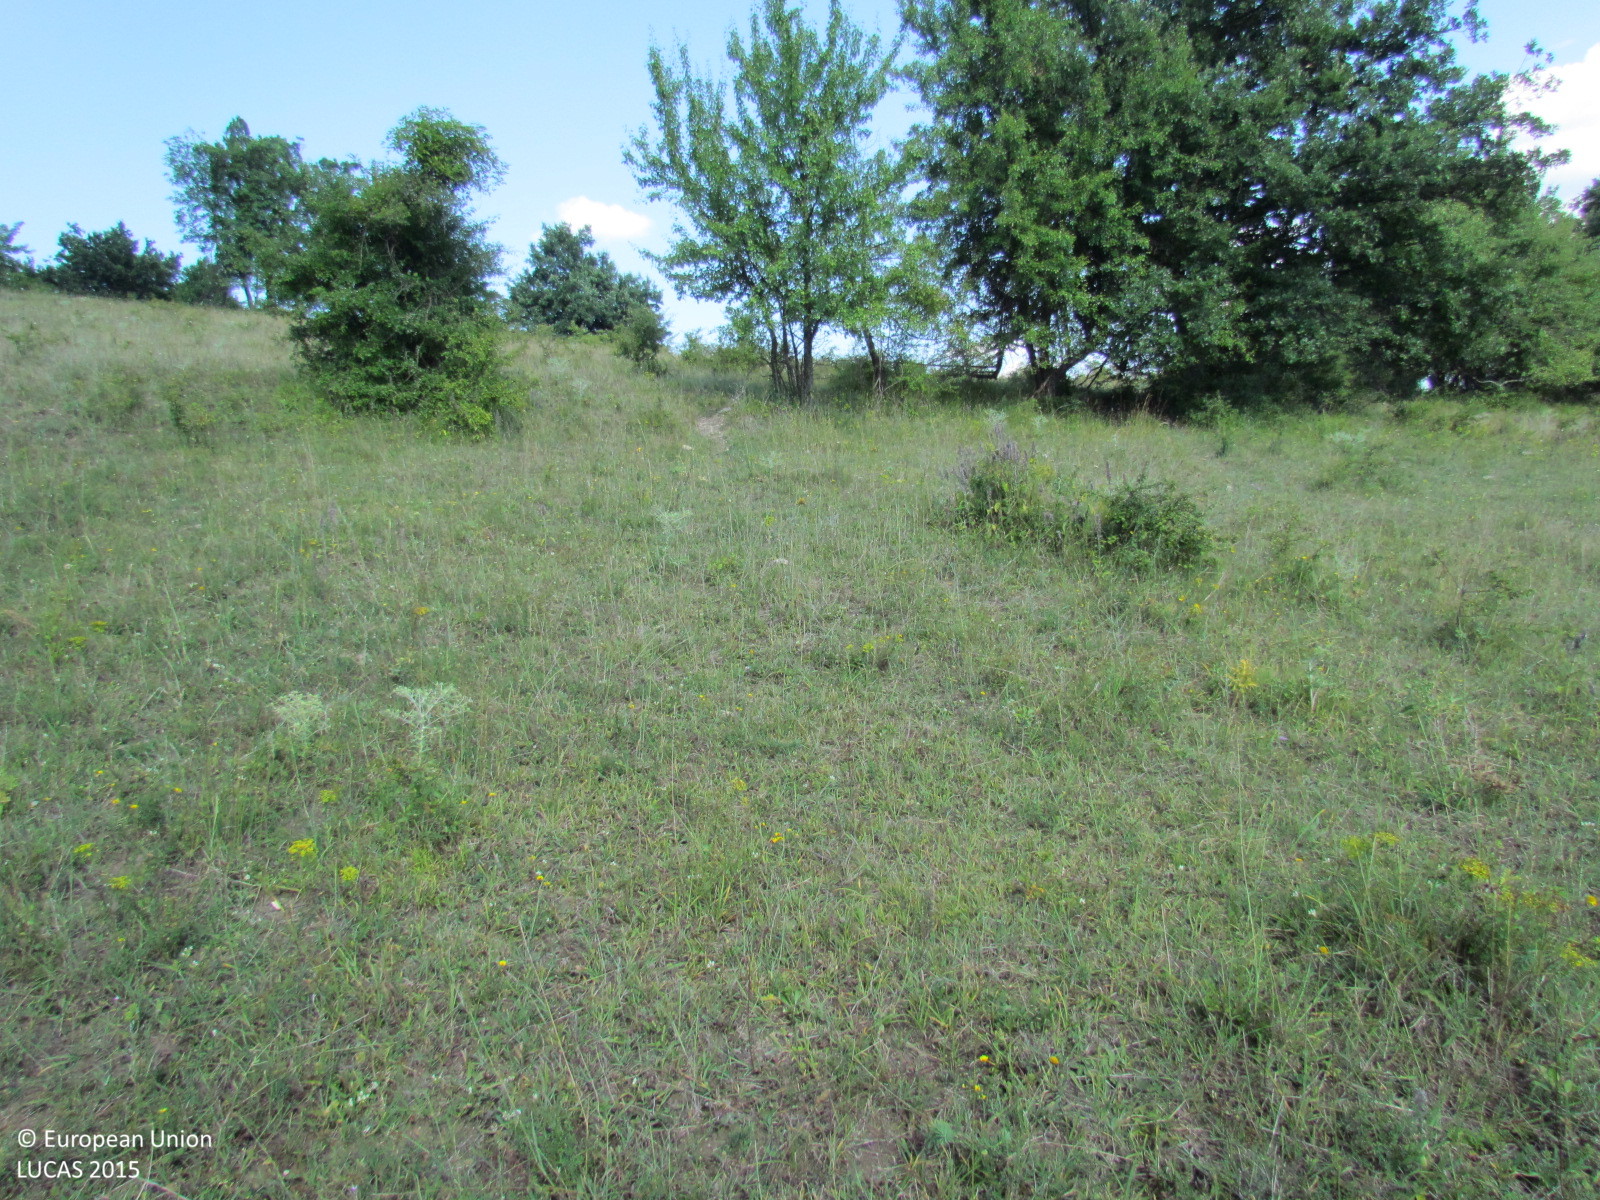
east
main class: Grassland
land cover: Grassland with sparse tree/shrub cover
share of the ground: > 75 %
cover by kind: herbaceous plants 90 %, broadleaved forest trees 5 %, shrubs 5 %
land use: Agriculture (excluding fallow land and kitchen gardens)
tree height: > 5 m
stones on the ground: < 10 %
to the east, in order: Grassland with sparse tree/shrub cover; Tracks; Shrubland with sparse tree cover; Grassland with sparse tree/shrub cover
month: July
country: BG
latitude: 42.8990
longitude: 27.4258
